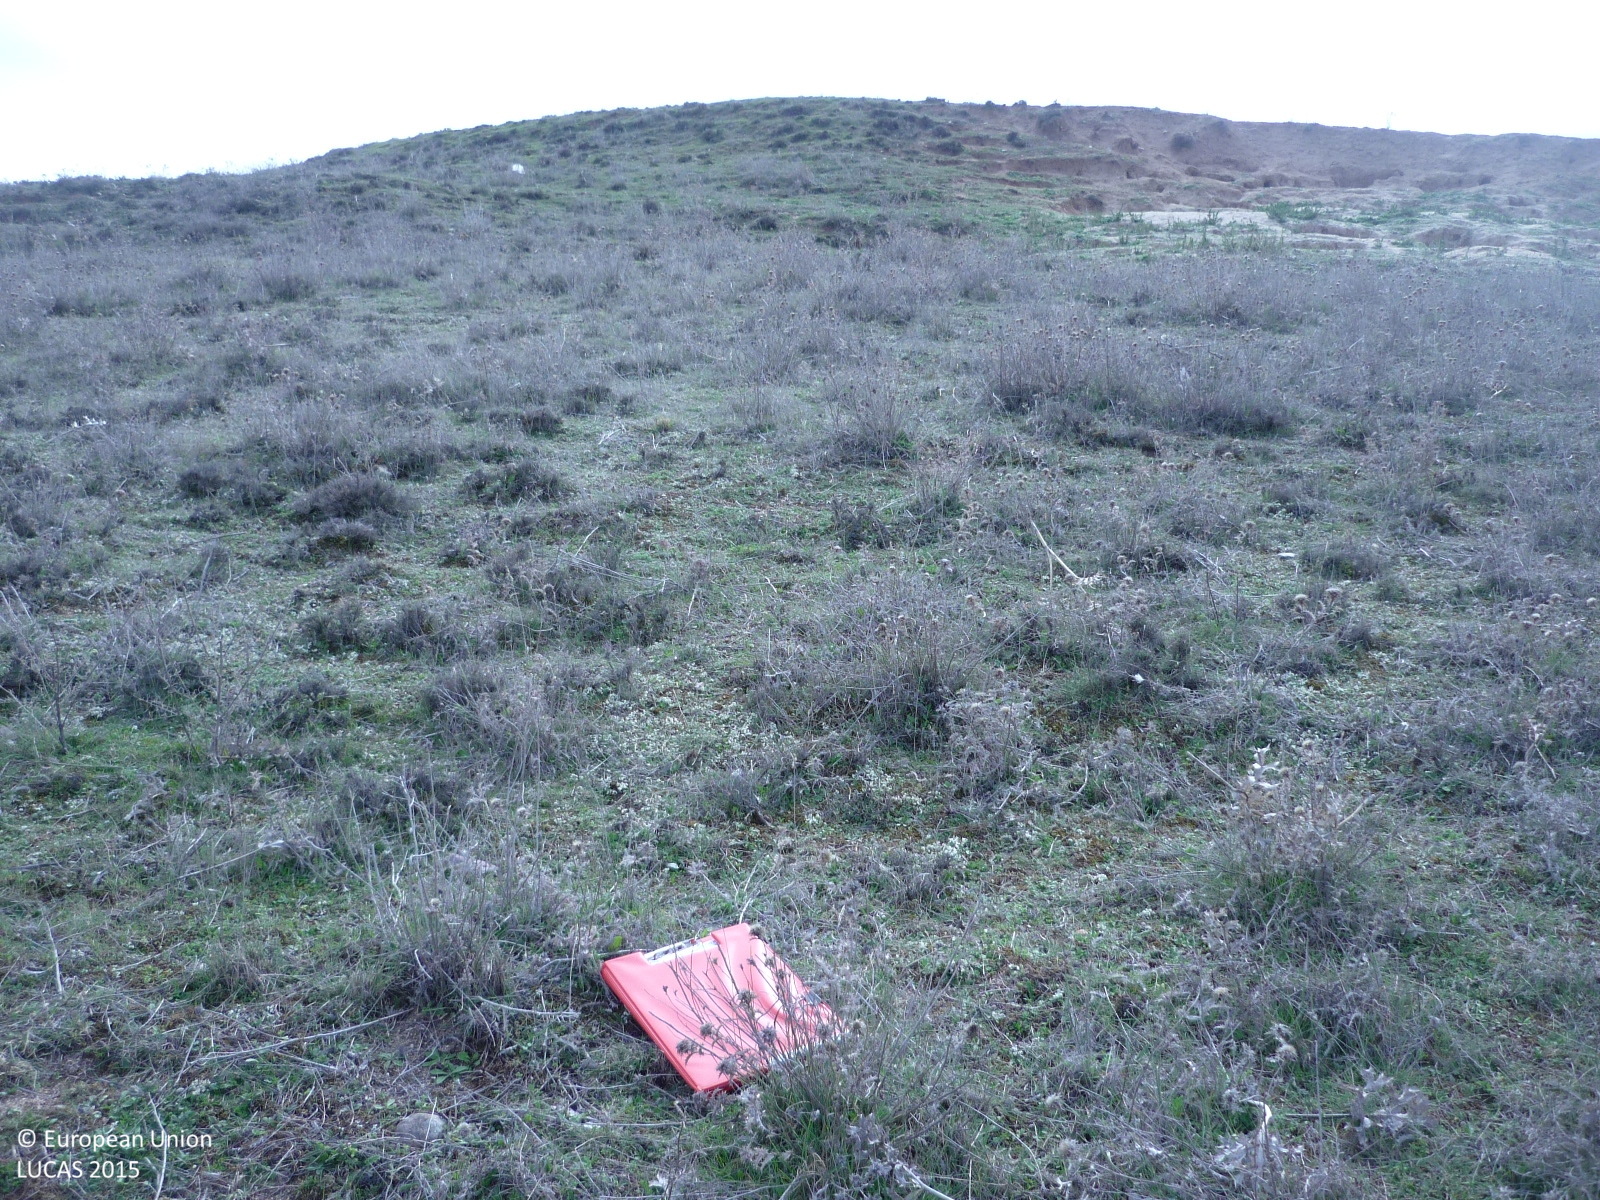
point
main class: Grassland
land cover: Grassland without tree/shrub cover
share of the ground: > 75 %
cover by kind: herbaceous plants 95 %, shrubs 5 %
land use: Semi-natural and natural areas not in use
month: March
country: ES
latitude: 40.5161
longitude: -3.5268
